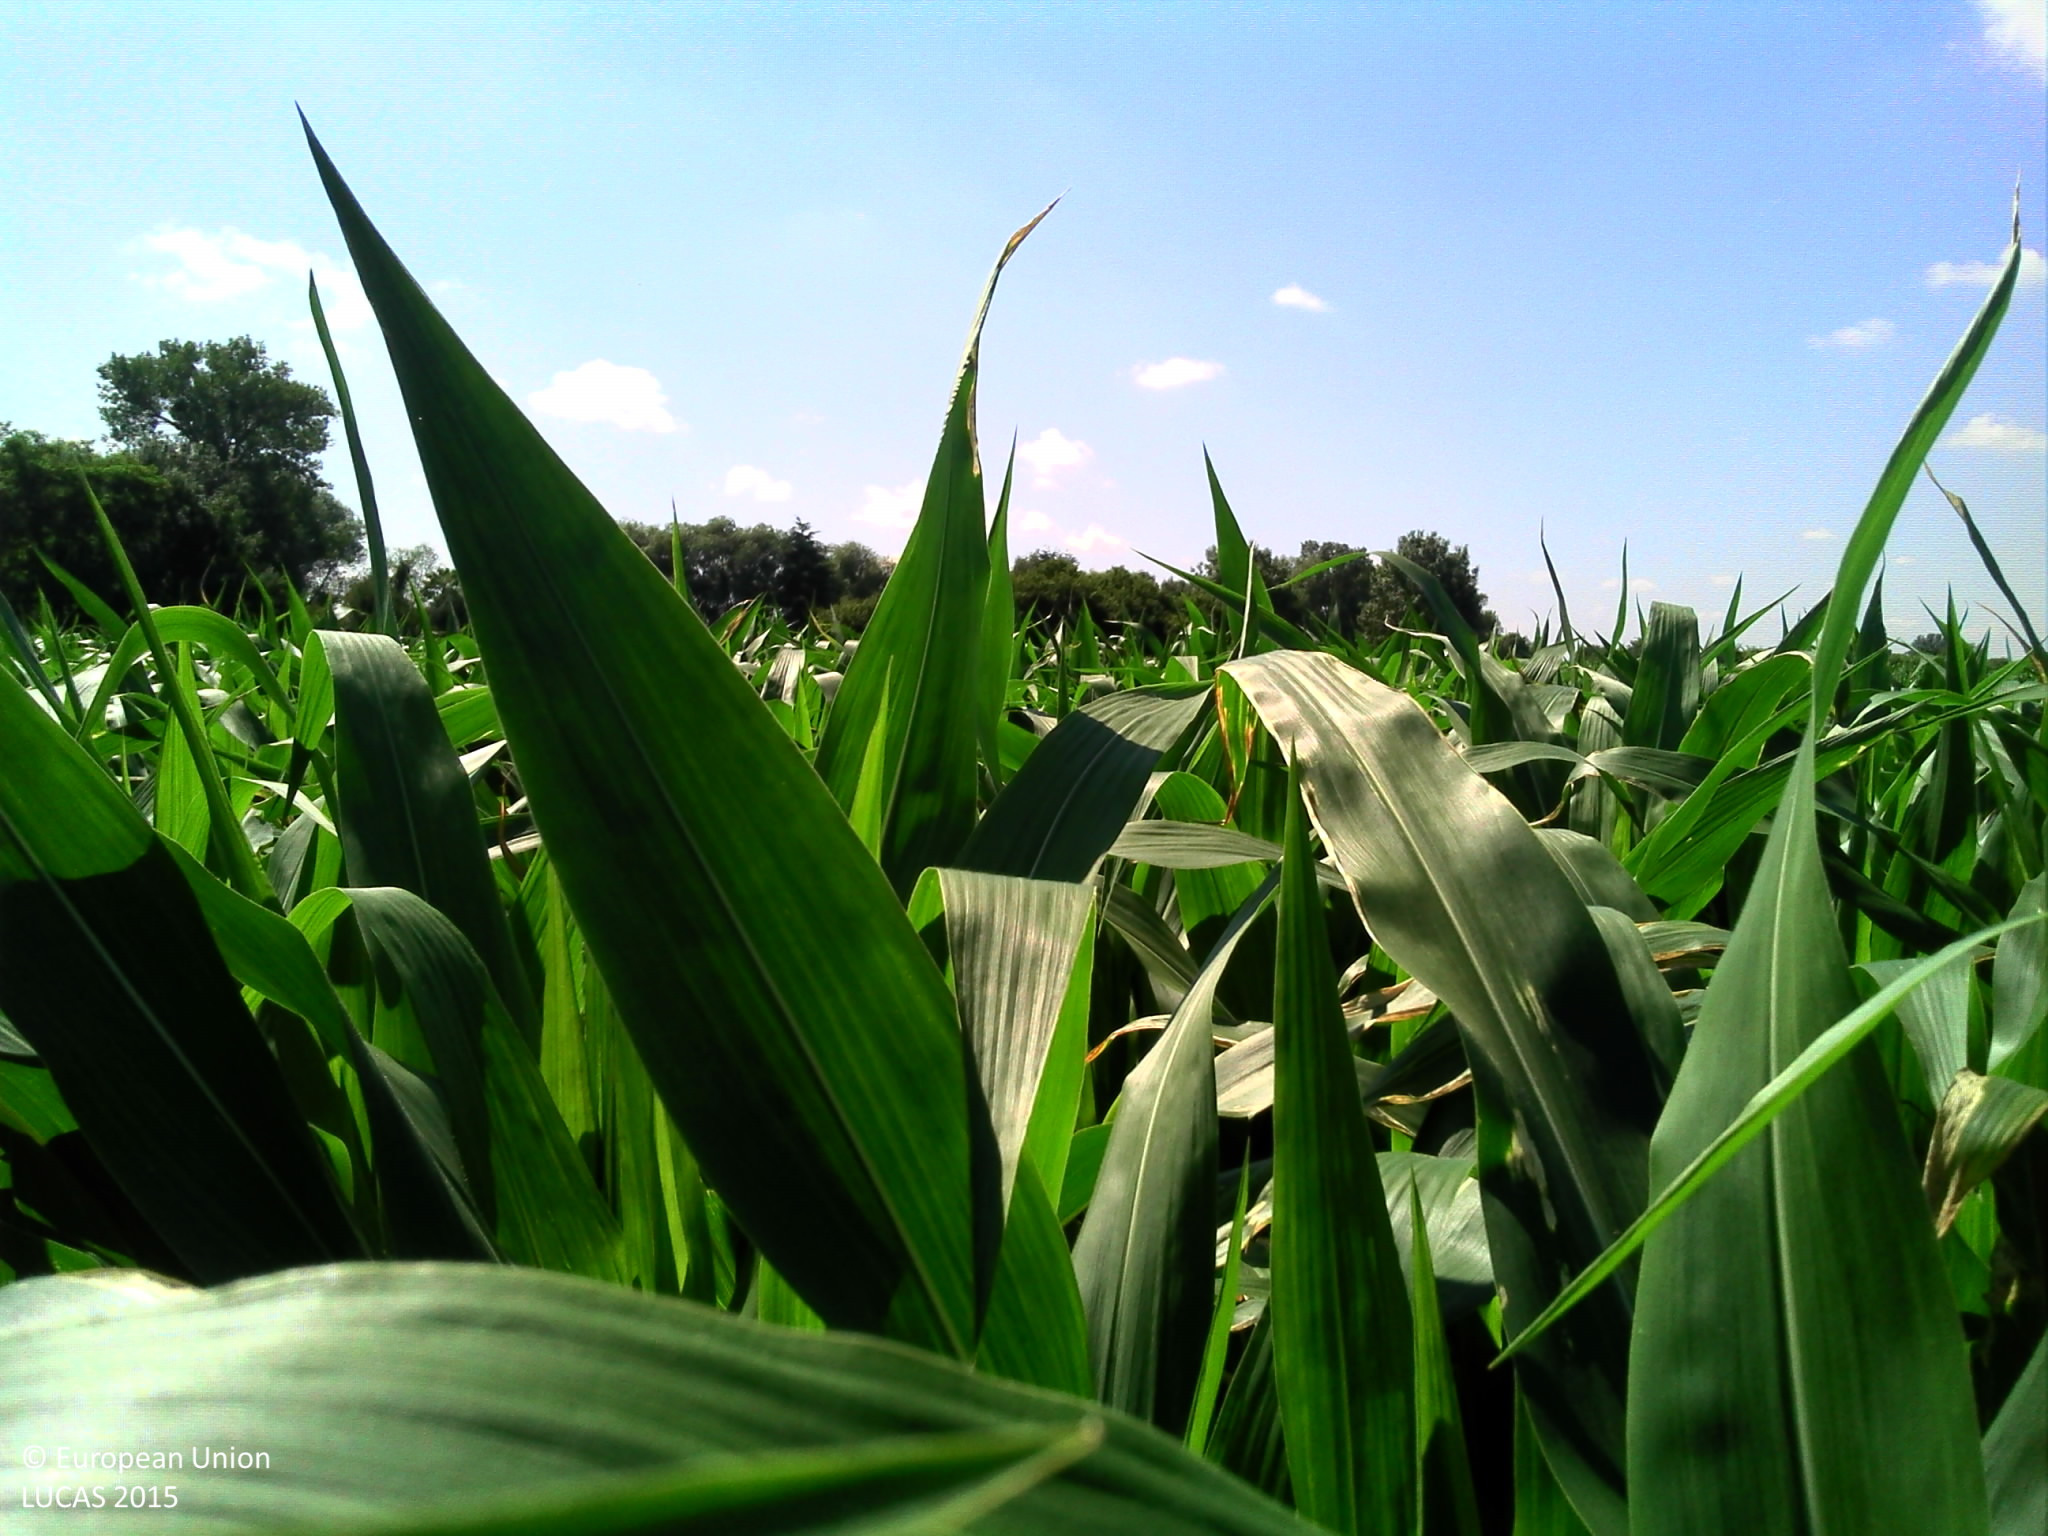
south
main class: Cropland
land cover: Maize
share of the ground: > 75 %
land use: Agriculture (excluding fallow land and kitchen gardens)
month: June
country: FR
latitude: 48.1391
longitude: 7.4074
